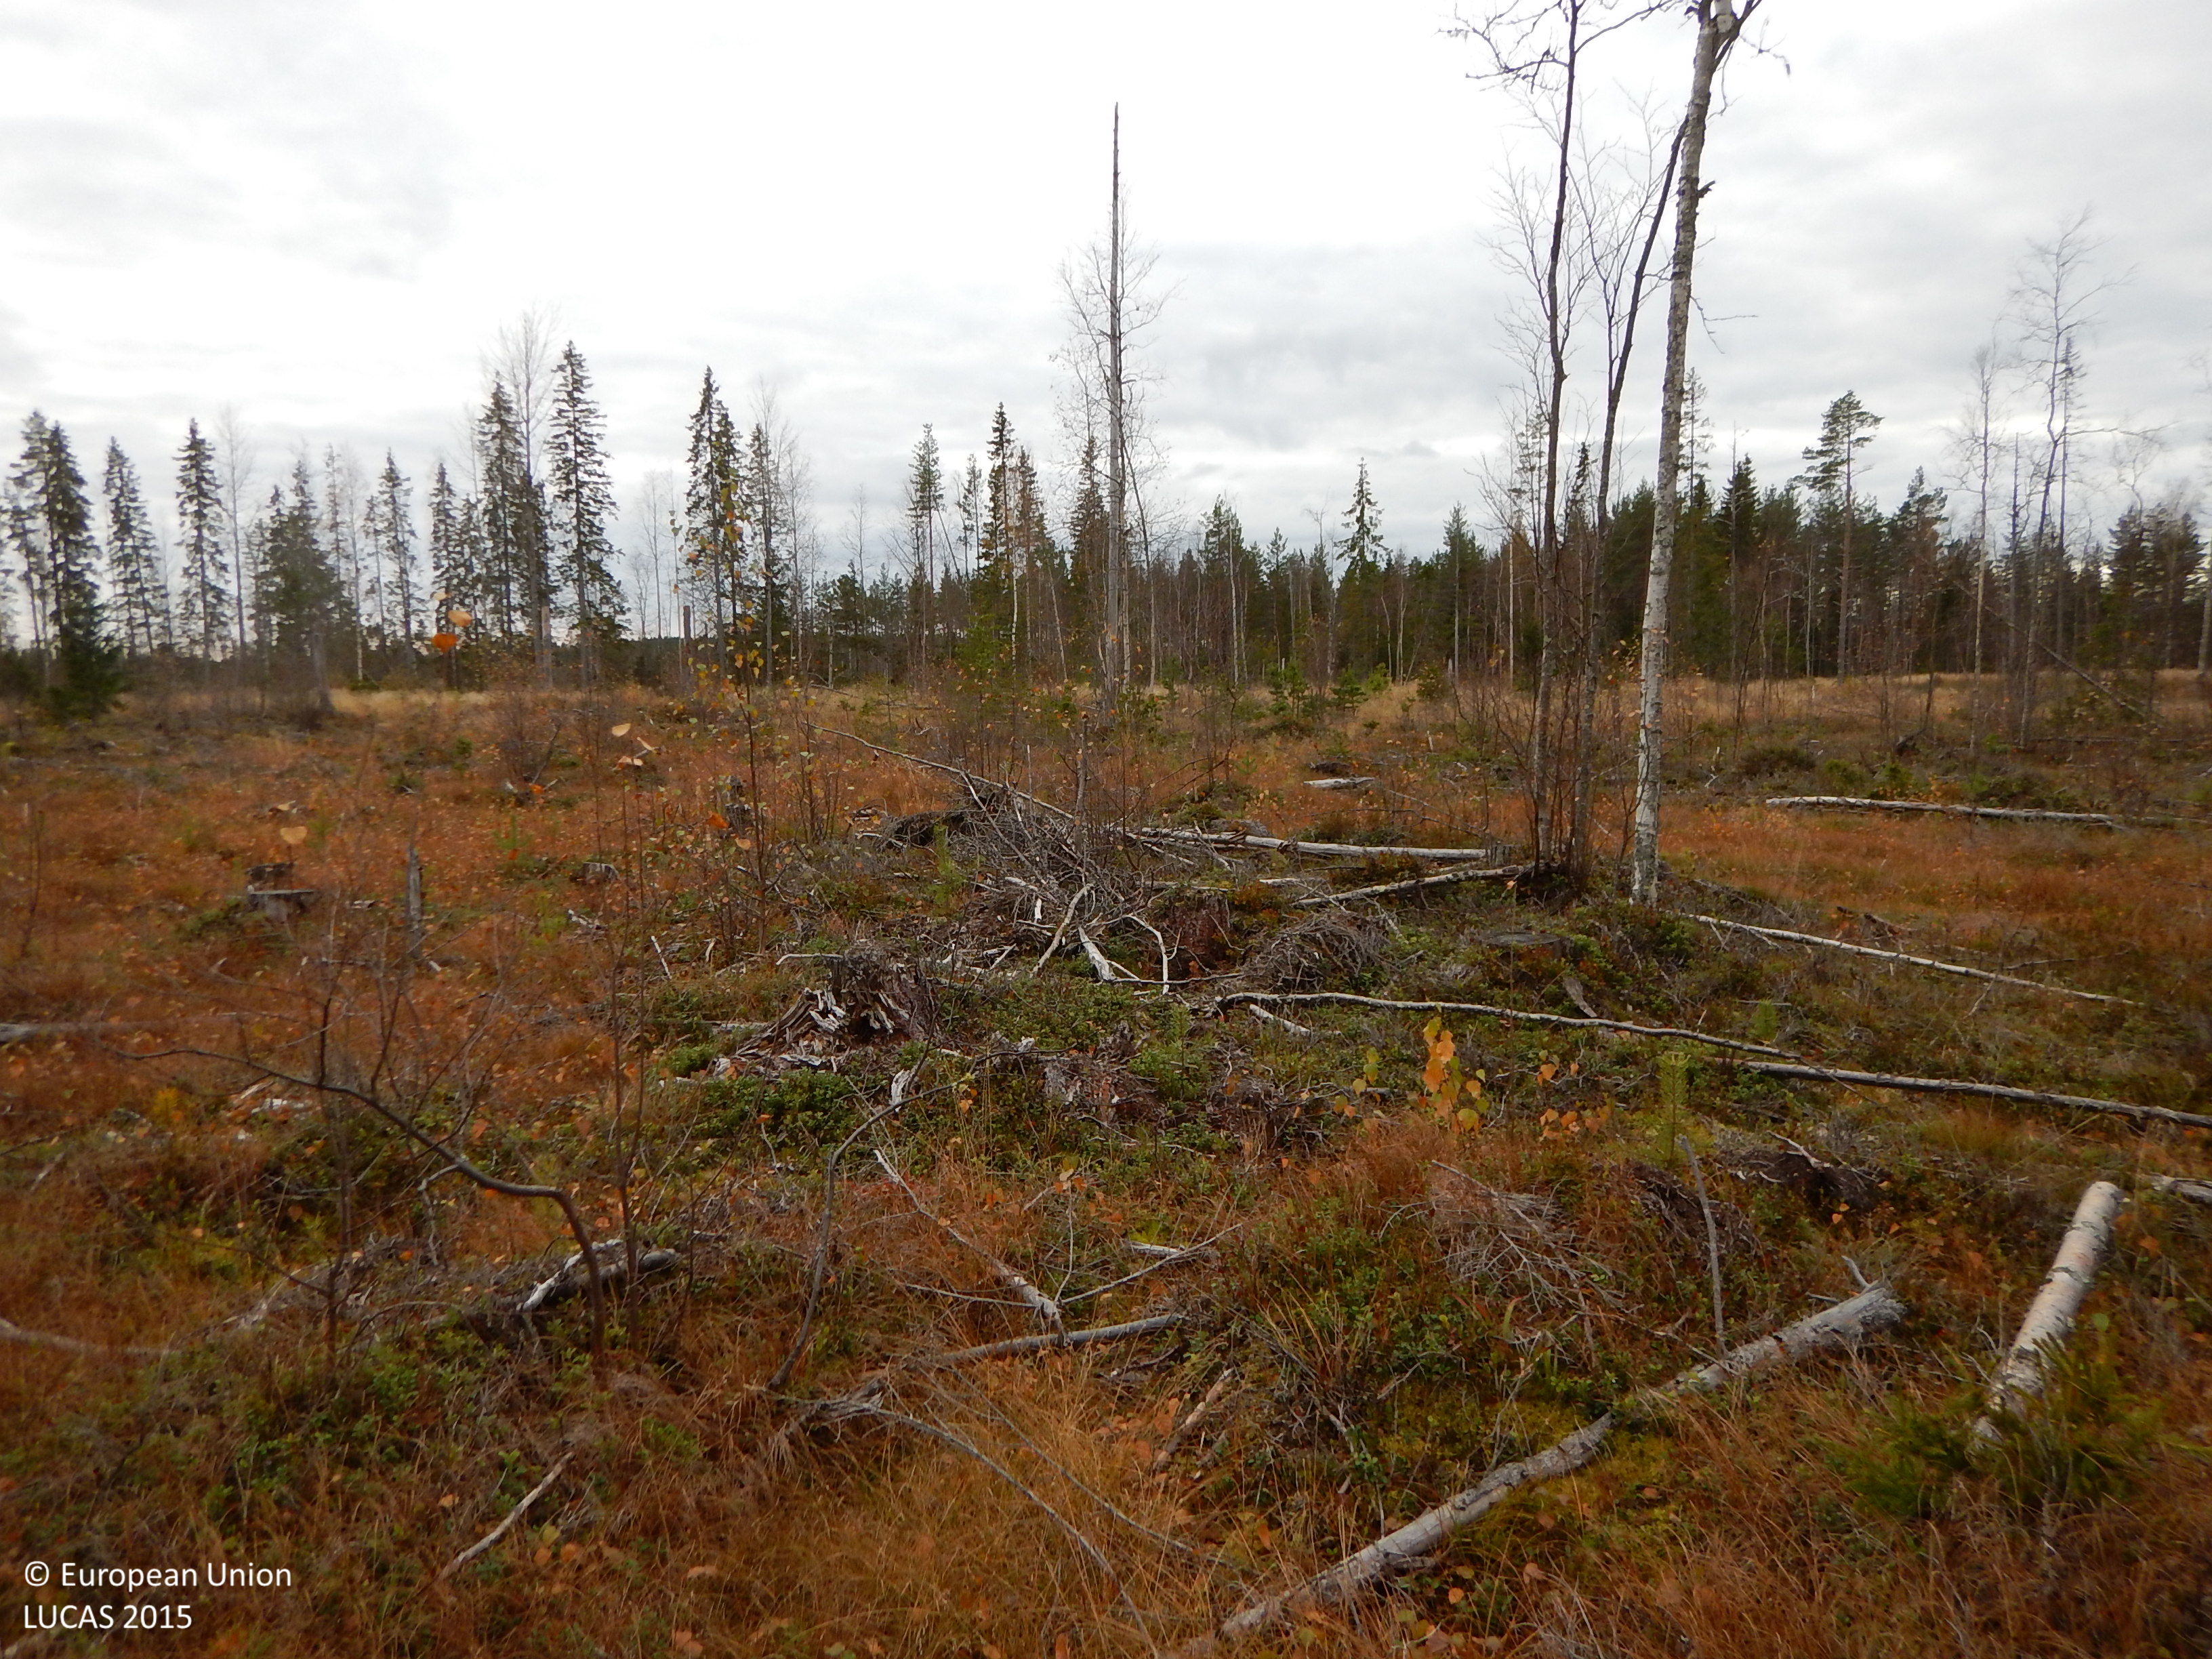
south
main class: Woodland
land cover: Other mixed woodland
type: boreal forest
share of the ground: 25 - 50 %
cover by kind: broadleaved forest trees 30 %, shrubs 25 %, herbaceous plants 20 %, lichens and mosses 15 %, coniferous forest trees 10 %
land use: Forestry
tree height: < 5 m
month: October
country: SE
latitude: 64.9765
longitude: 21.1005
